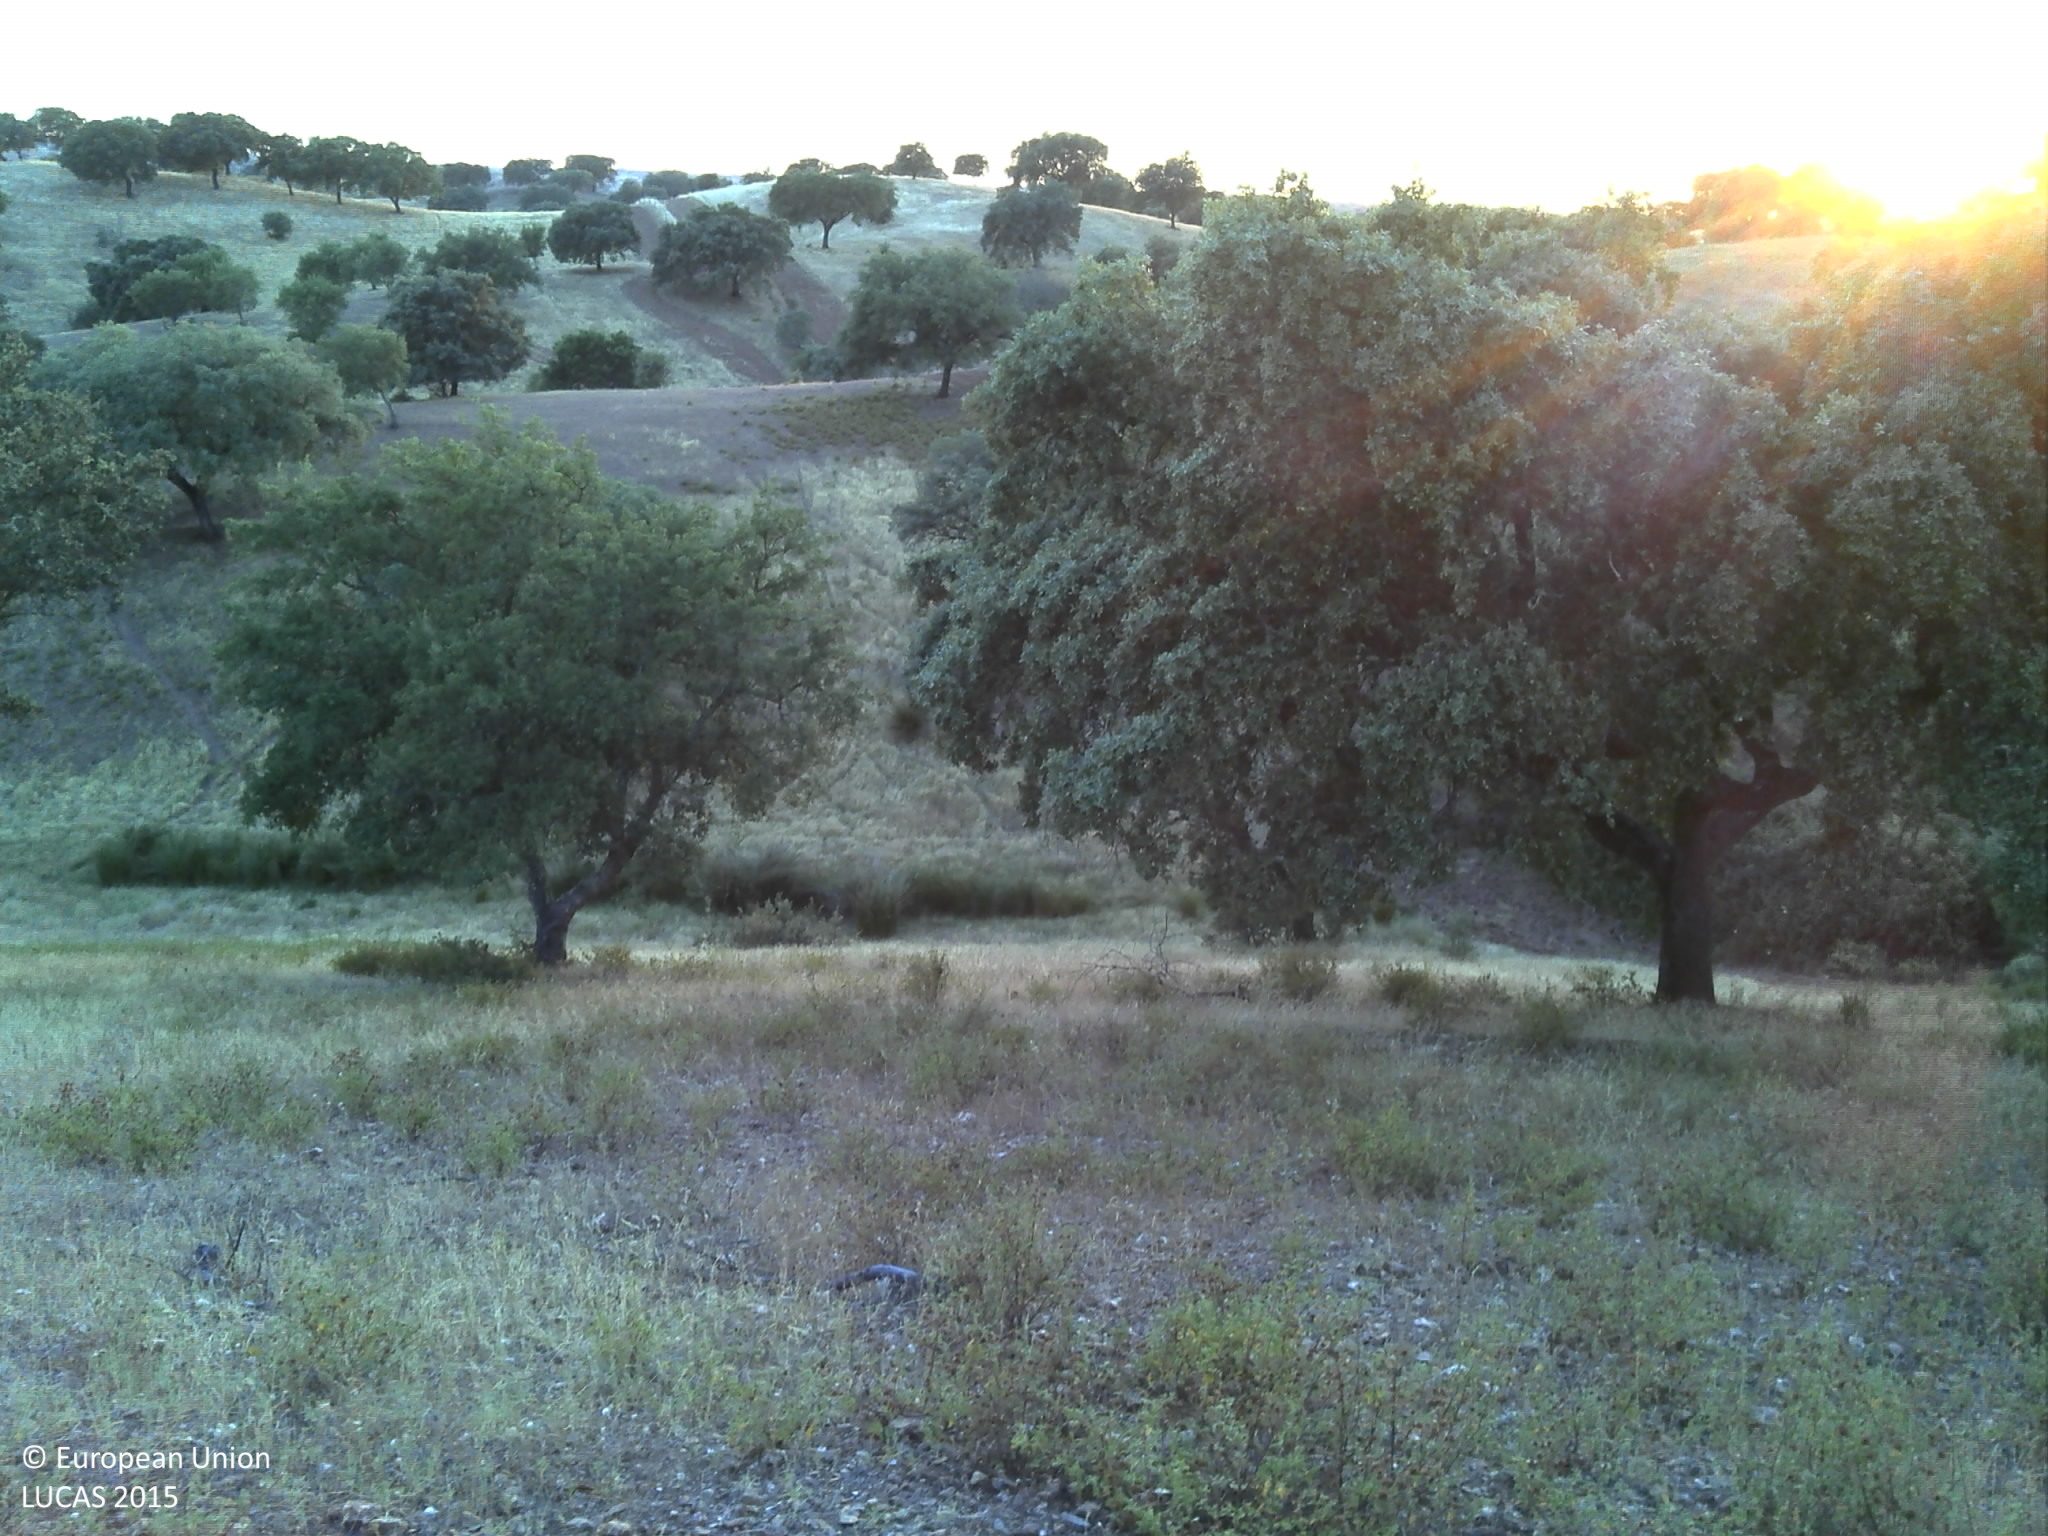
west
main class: Woodland
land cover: Broadleaved woodland
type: broadleaved evergreen forest
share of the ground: 10 - 25 %
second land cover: Grassland without tree/shrub cover
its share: 25 - 50 %
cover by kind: herbaceous plants 50 %, broadleaved forest trees 25 %, unconsolidated bare surface 25 %
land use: Forestry
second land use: Agriculture (excluding fallow land and kitchen gardens)
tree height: > 5 m
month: June
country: PT
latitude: 37.7818
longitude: -7.4658
